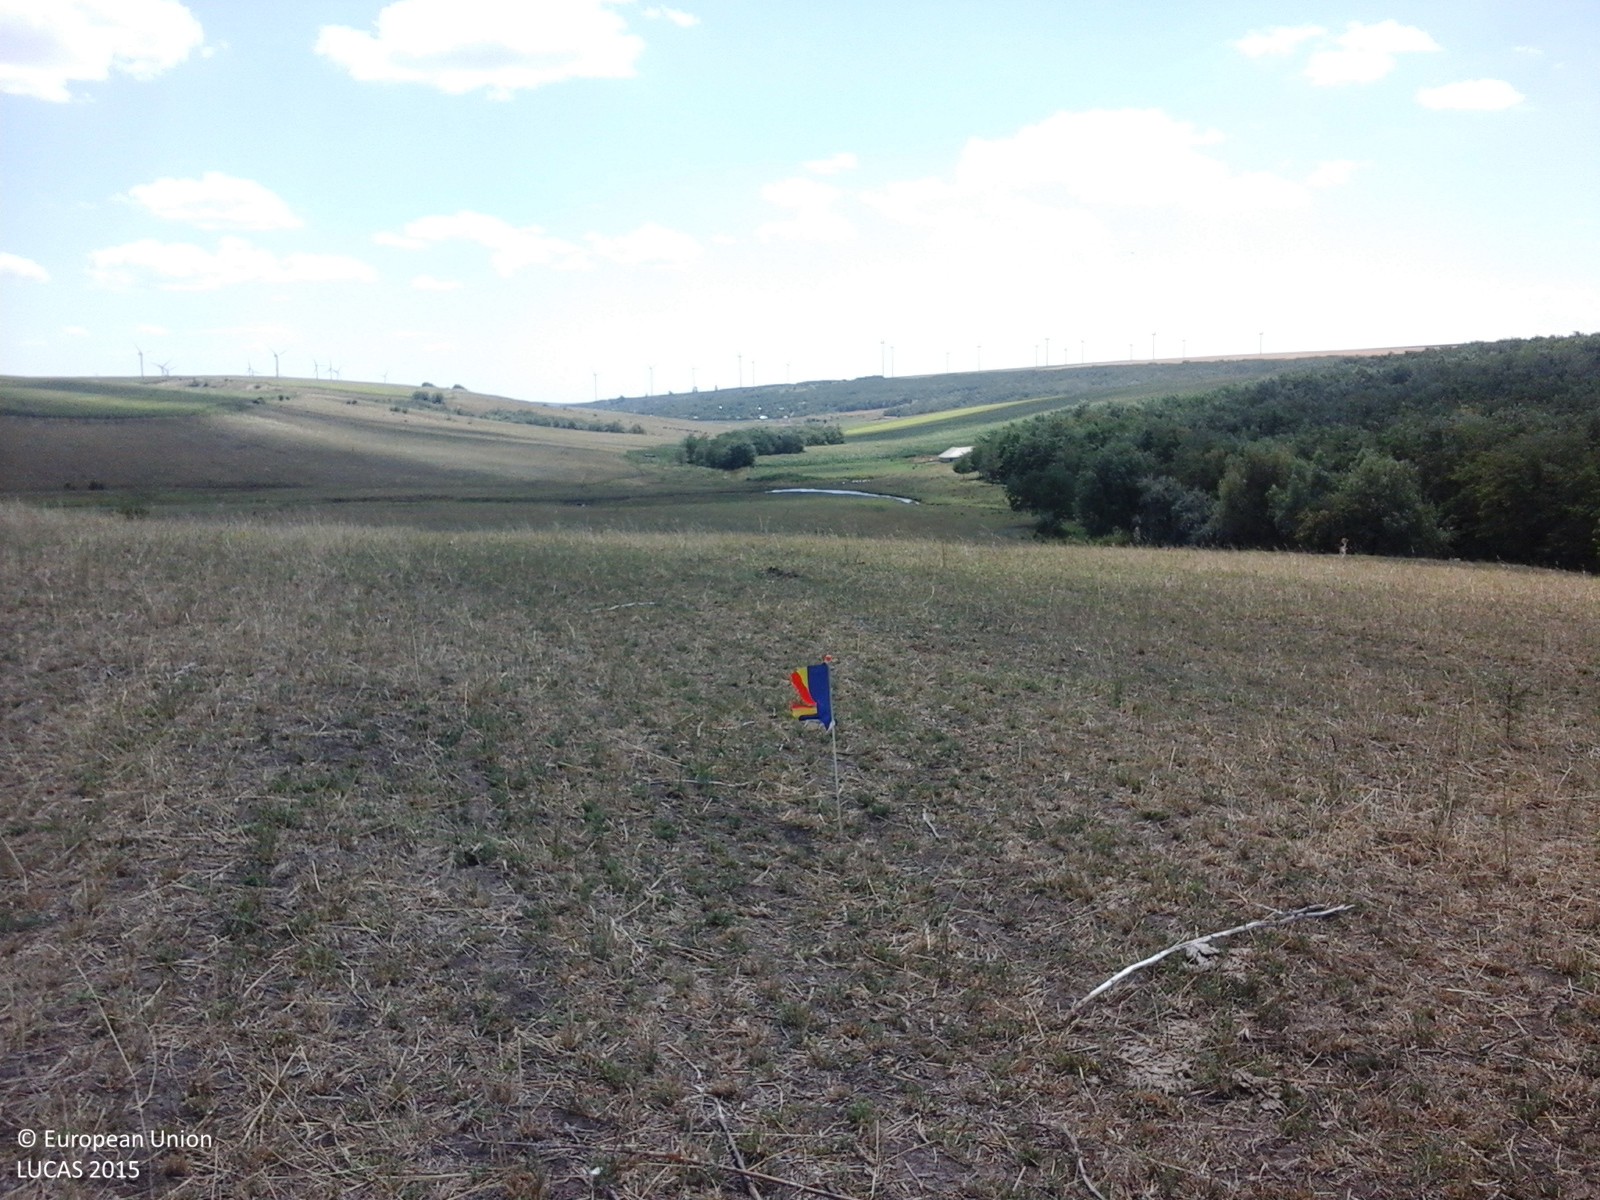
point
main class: Grassland
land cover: Grassland without tree/shrub cover
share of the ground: > 75 %
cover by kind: herbaceous plants 100 %
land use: Agriculture (excluding fallow land and kitchen gardens)
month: July
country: RO
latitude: 45.8825
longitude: 27.7532
